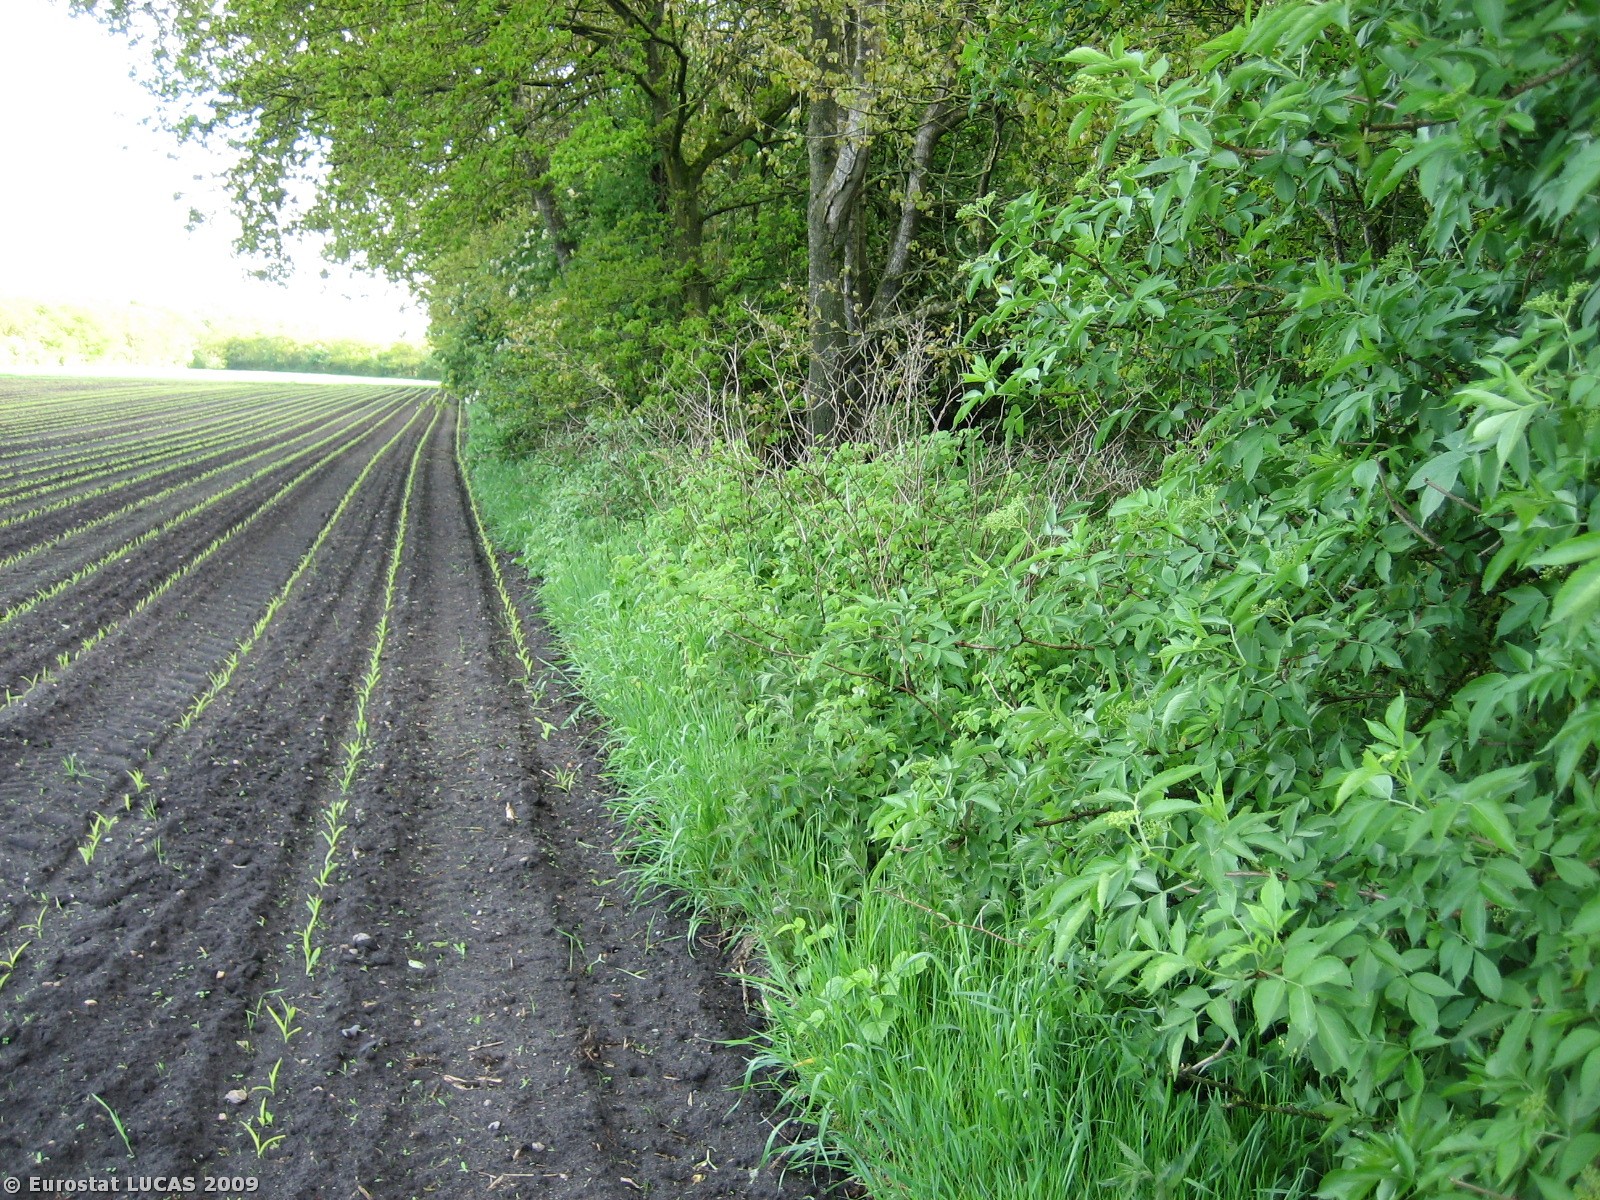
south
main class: Cropland
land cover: Maize
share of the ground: < 10 %
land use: Agriculture (excluding fallow land and kitchen gardens)
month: May
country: DK
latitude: 56.2354
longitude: 8.7270
